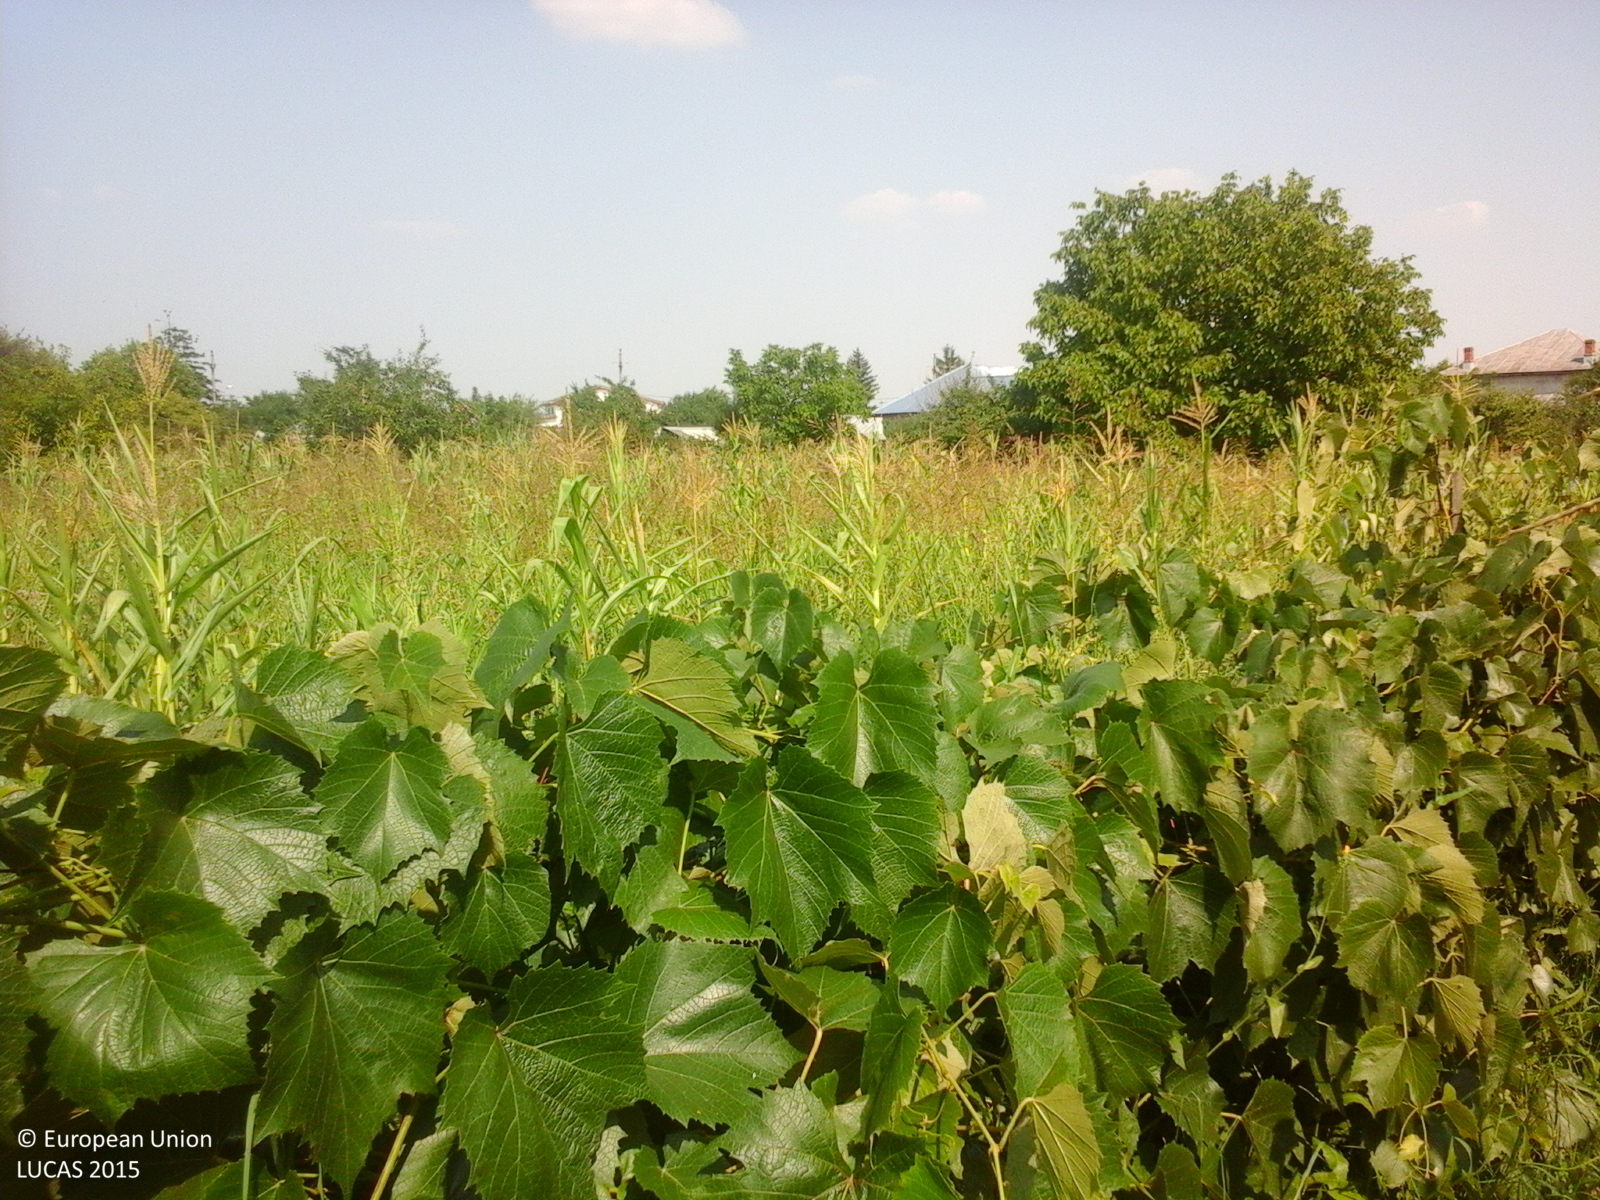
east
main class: Cropland
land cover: Maize
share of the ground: > 75 %
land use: Agriculture (excluding fallow land and kitchen gardens)
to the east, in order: Maize; Vineyards; Maize; Arable land (only in case pi); Fences; Abandoned hedges; Arable land (only in case pi); Artificial constructions in urban areas; Lucerne
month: July
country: RO
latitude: 44.5997
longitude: 25.9133
